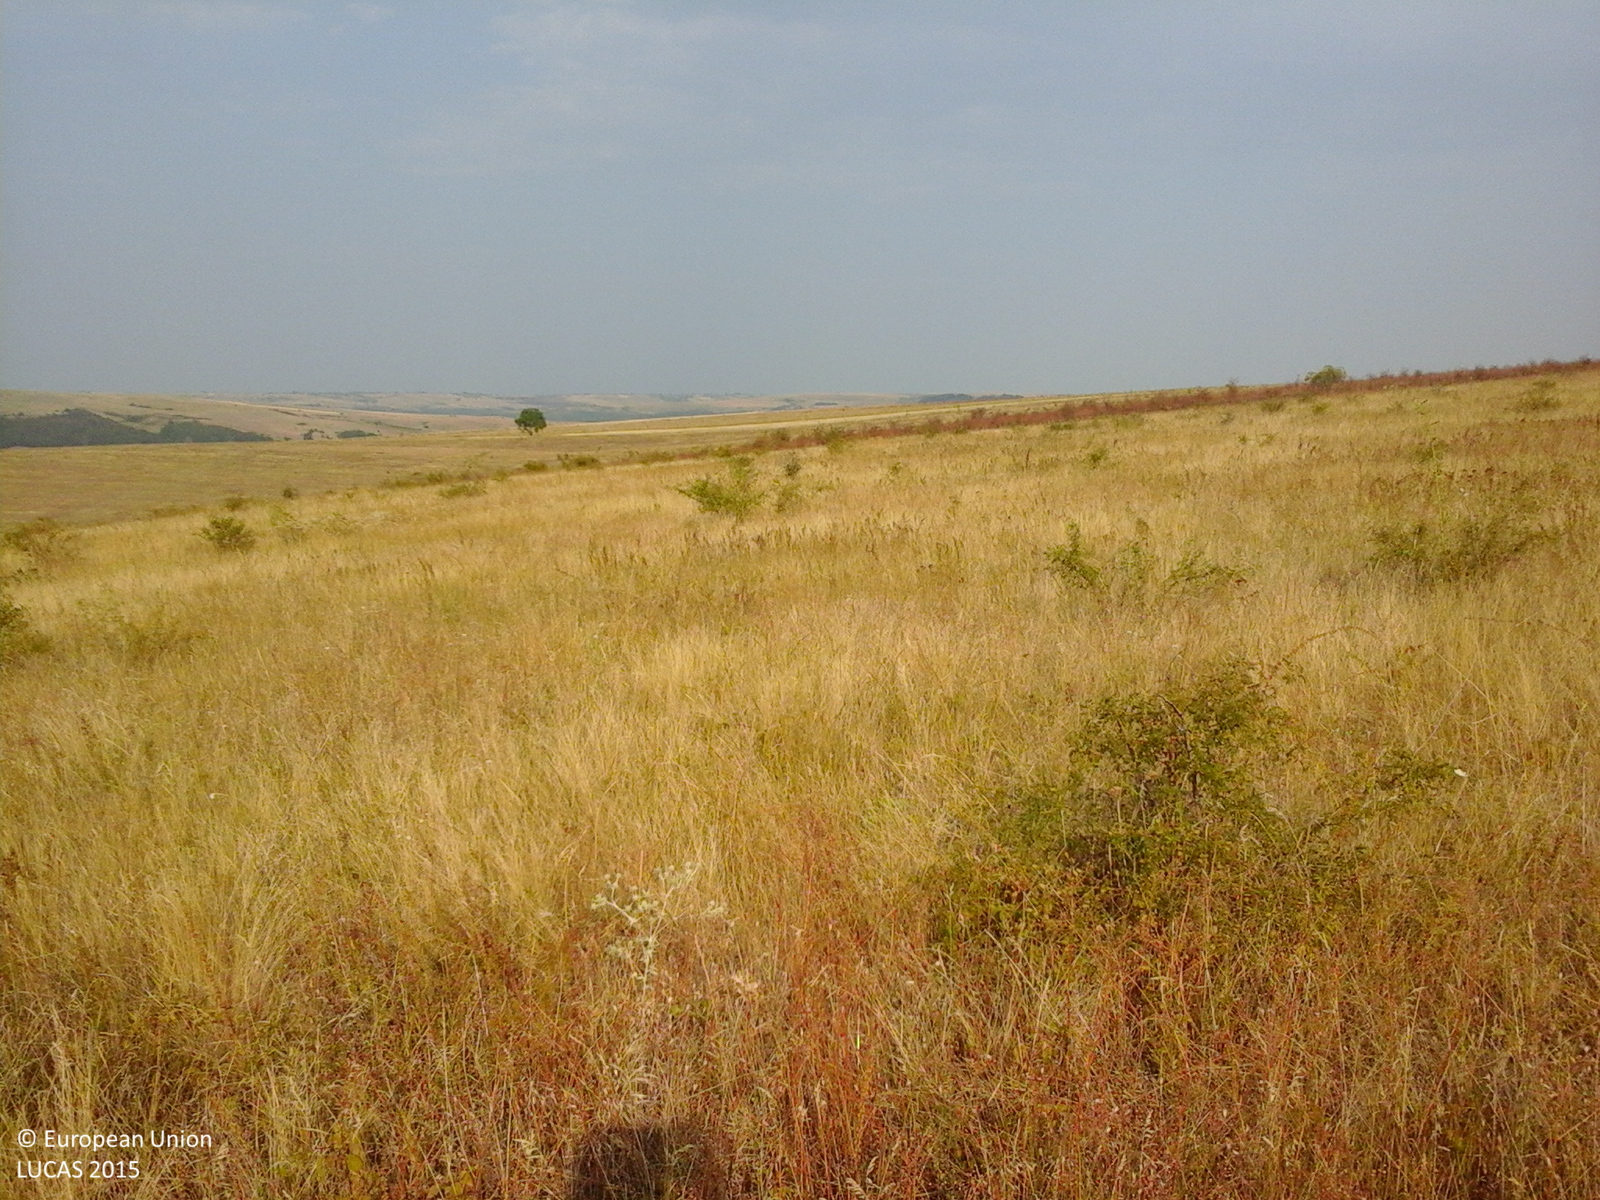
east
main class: Grassland
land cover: Grassland without tree/shrub cover
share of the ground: > 75 %
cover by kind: herbaceous plants 100 %
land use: Agriculture (excluding fallow land and kitchen gardens)
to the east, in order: Grassland without tree/shrub cover; Grassland with sparse tree/shrub cover; Common wheat
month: August
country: RO
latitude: 44.4769
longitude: 23.0071
